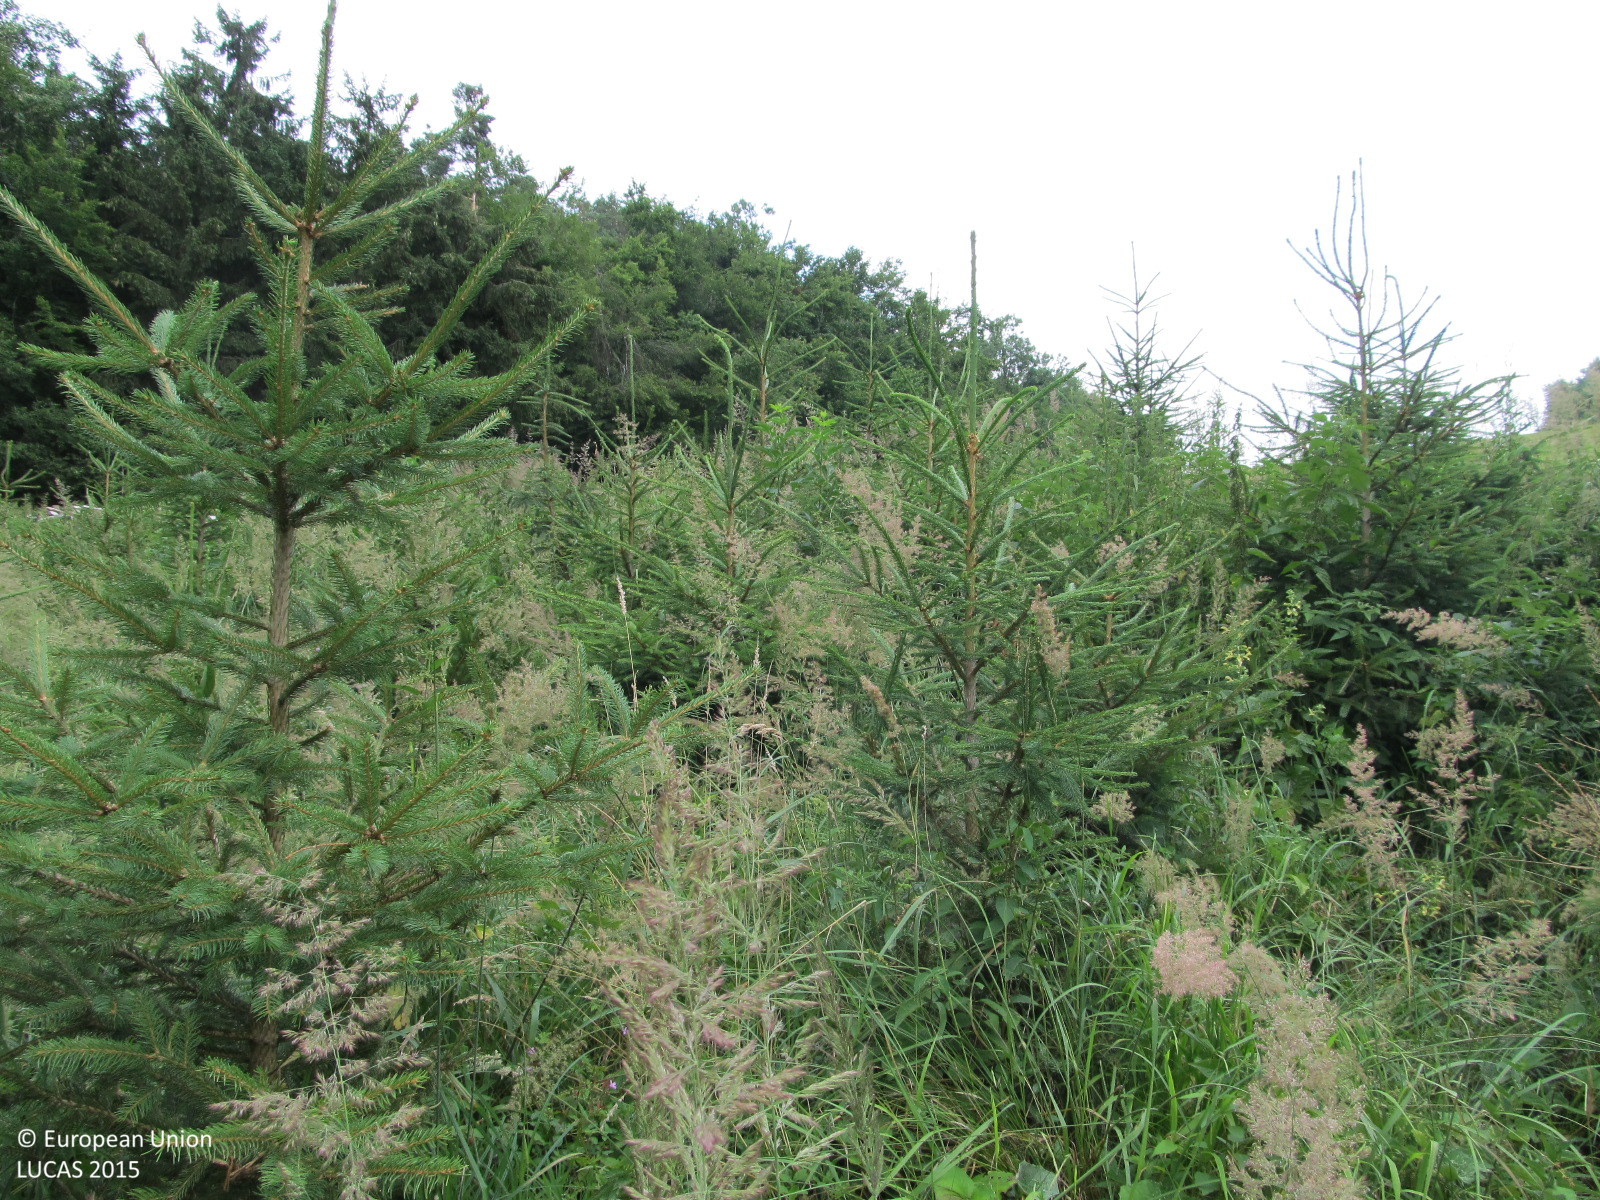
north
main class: Woodland
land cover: Spruce dominated coniferous woodland
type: hemiboreal forest and nemoral coniferous forest and mixed broadleaved-coniferous forest
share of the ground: > 75 %
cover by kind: coniferous forest trees 50 %, herbaceous plants 40 %, shrubs 10 %
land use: Forestry
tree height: < 5 m
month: July
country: AT
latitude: 48.4700
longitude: 15.3992
